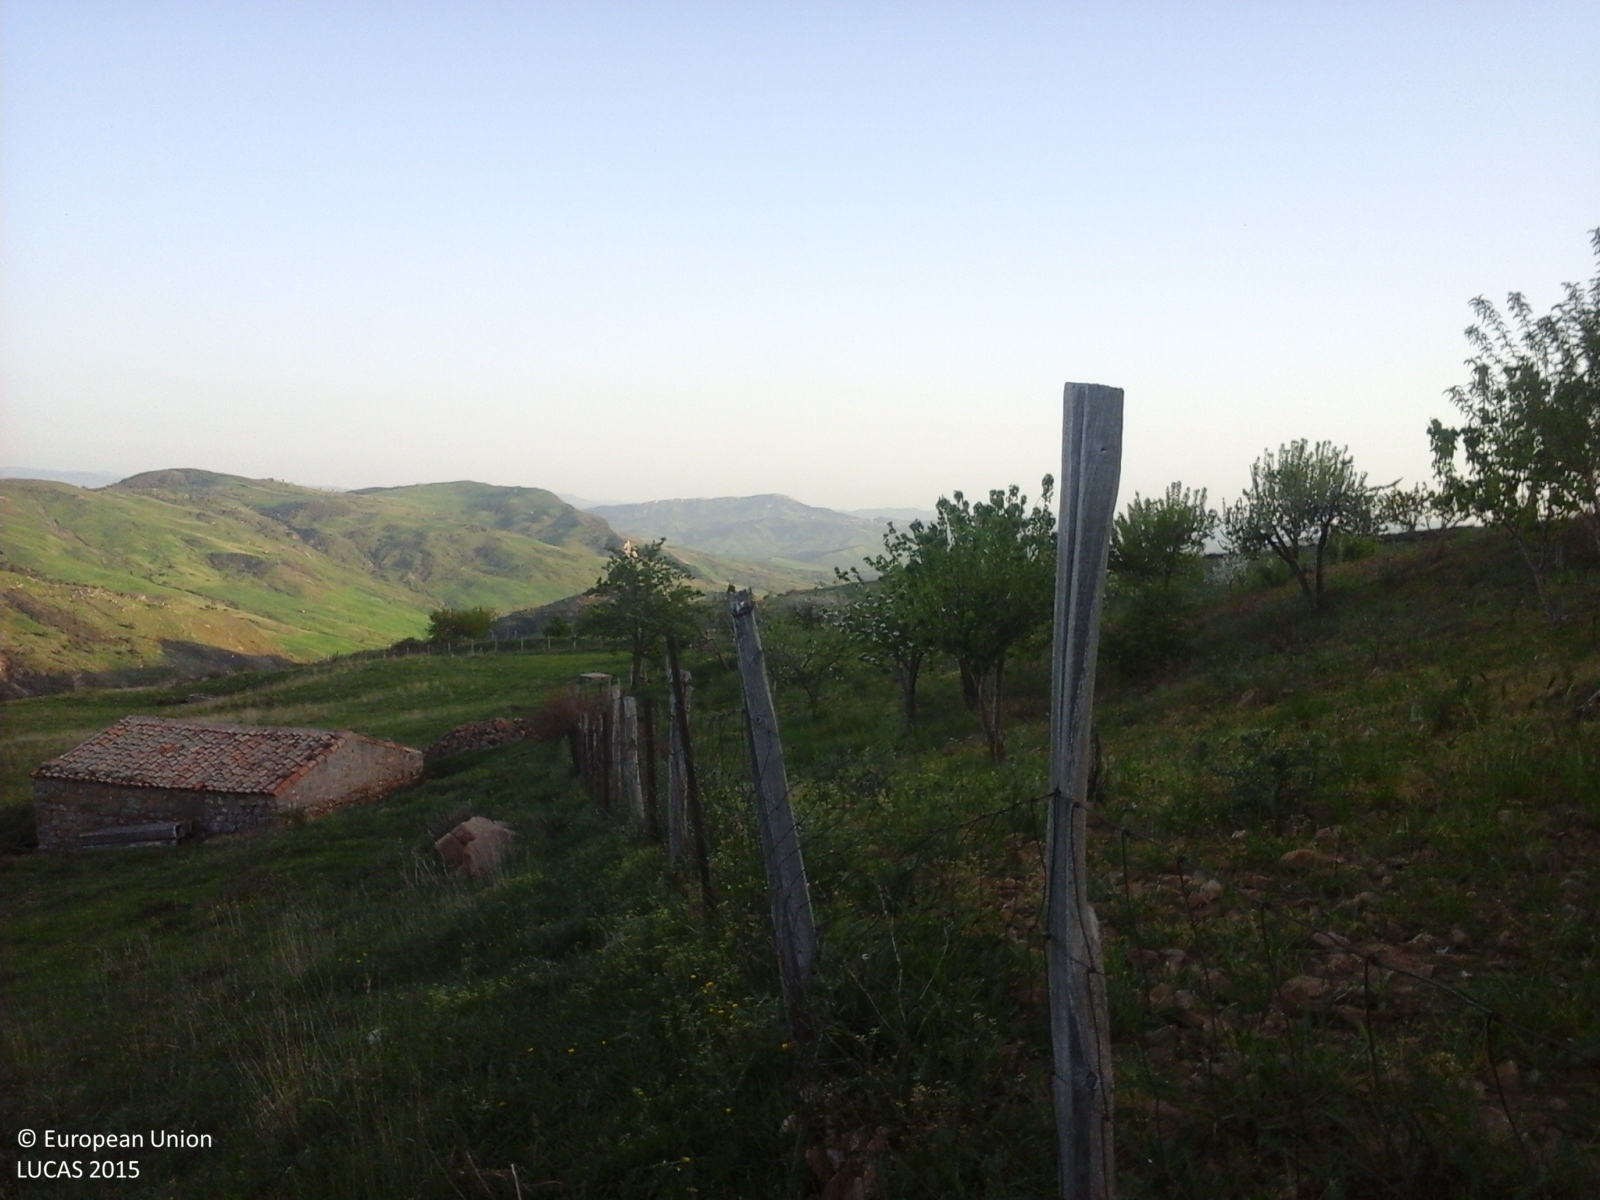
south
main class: Cropland
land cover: Pear fruit
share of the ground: 25 - 50 %
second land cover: Spontaneously vegetated surfaces
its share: > 75 %
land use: Agriculture (excluding fallow land and kitchen gardens)
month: May
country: IT
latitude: 37.8210
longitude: 14.1398
